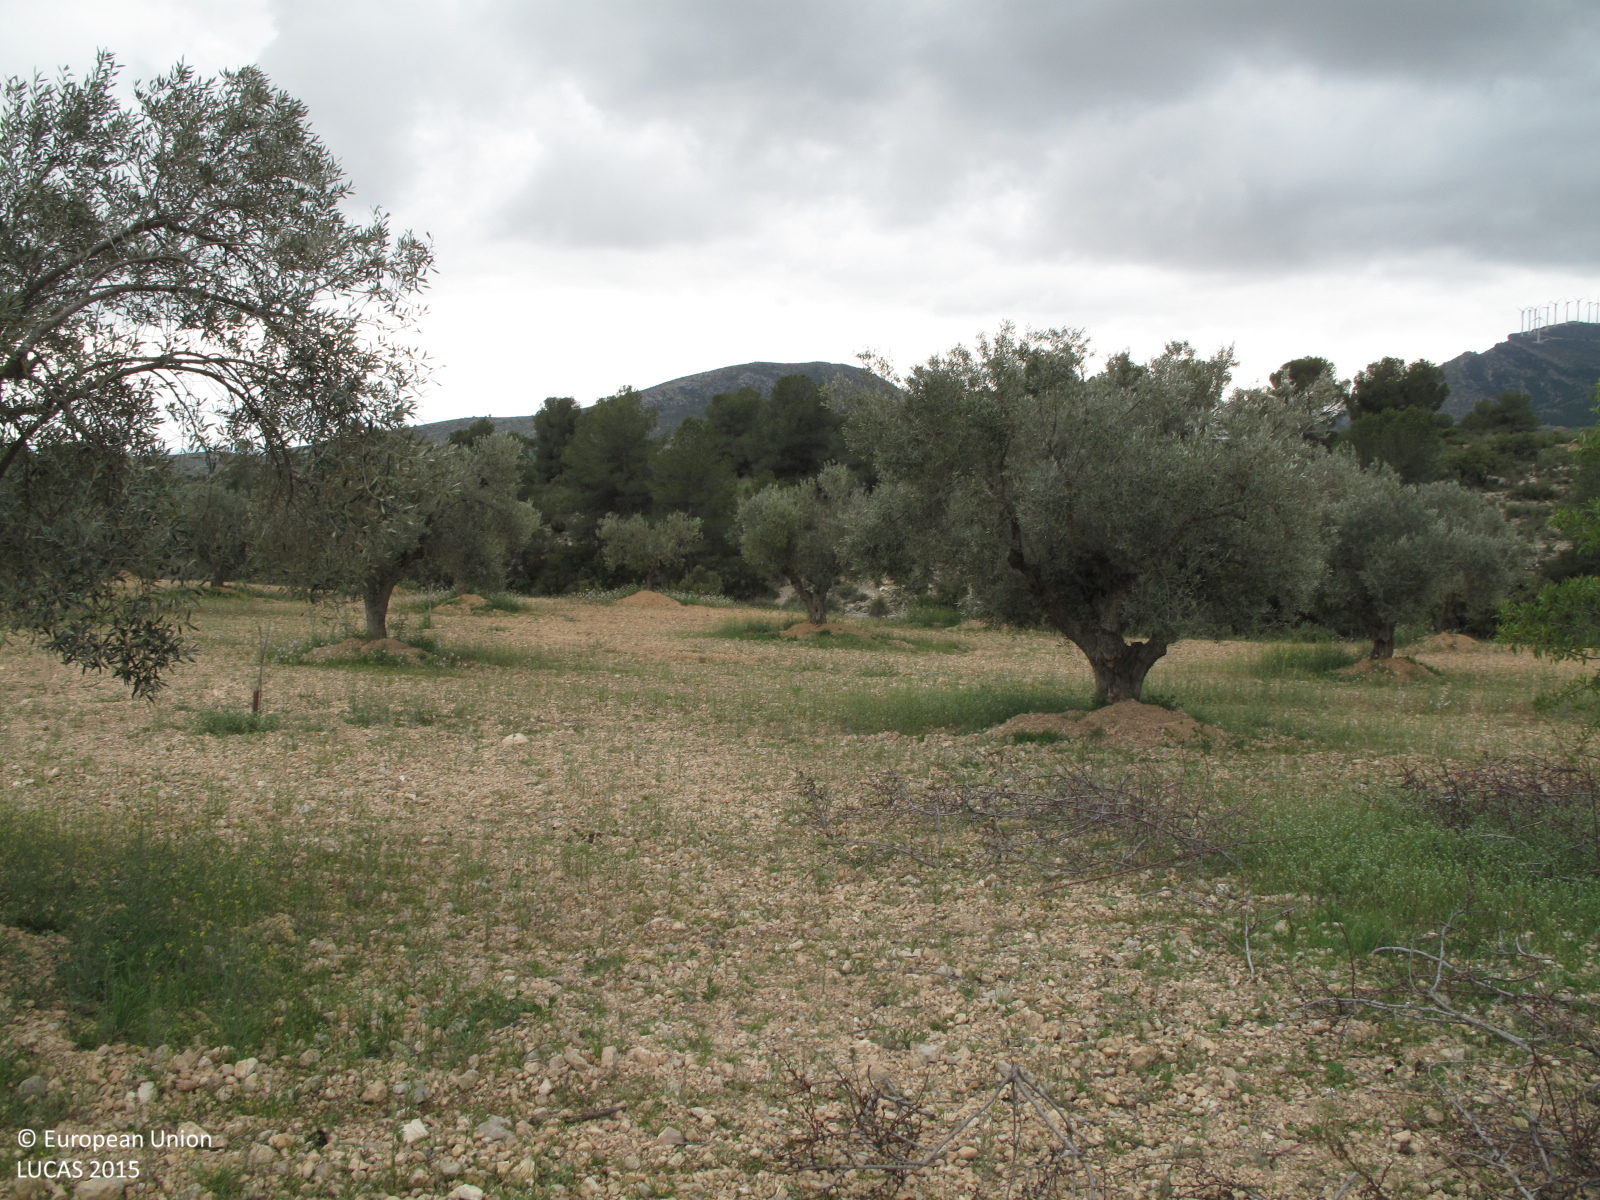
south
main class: Cropland
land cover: Olive groves
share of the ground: 25 - 50 %
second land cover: Nuts trees
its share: 25 - 50 %
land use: Agriculture (excluding fallow land and kitchen gardens)
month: April
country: ES
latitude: 38.7724
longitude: -0.9844
